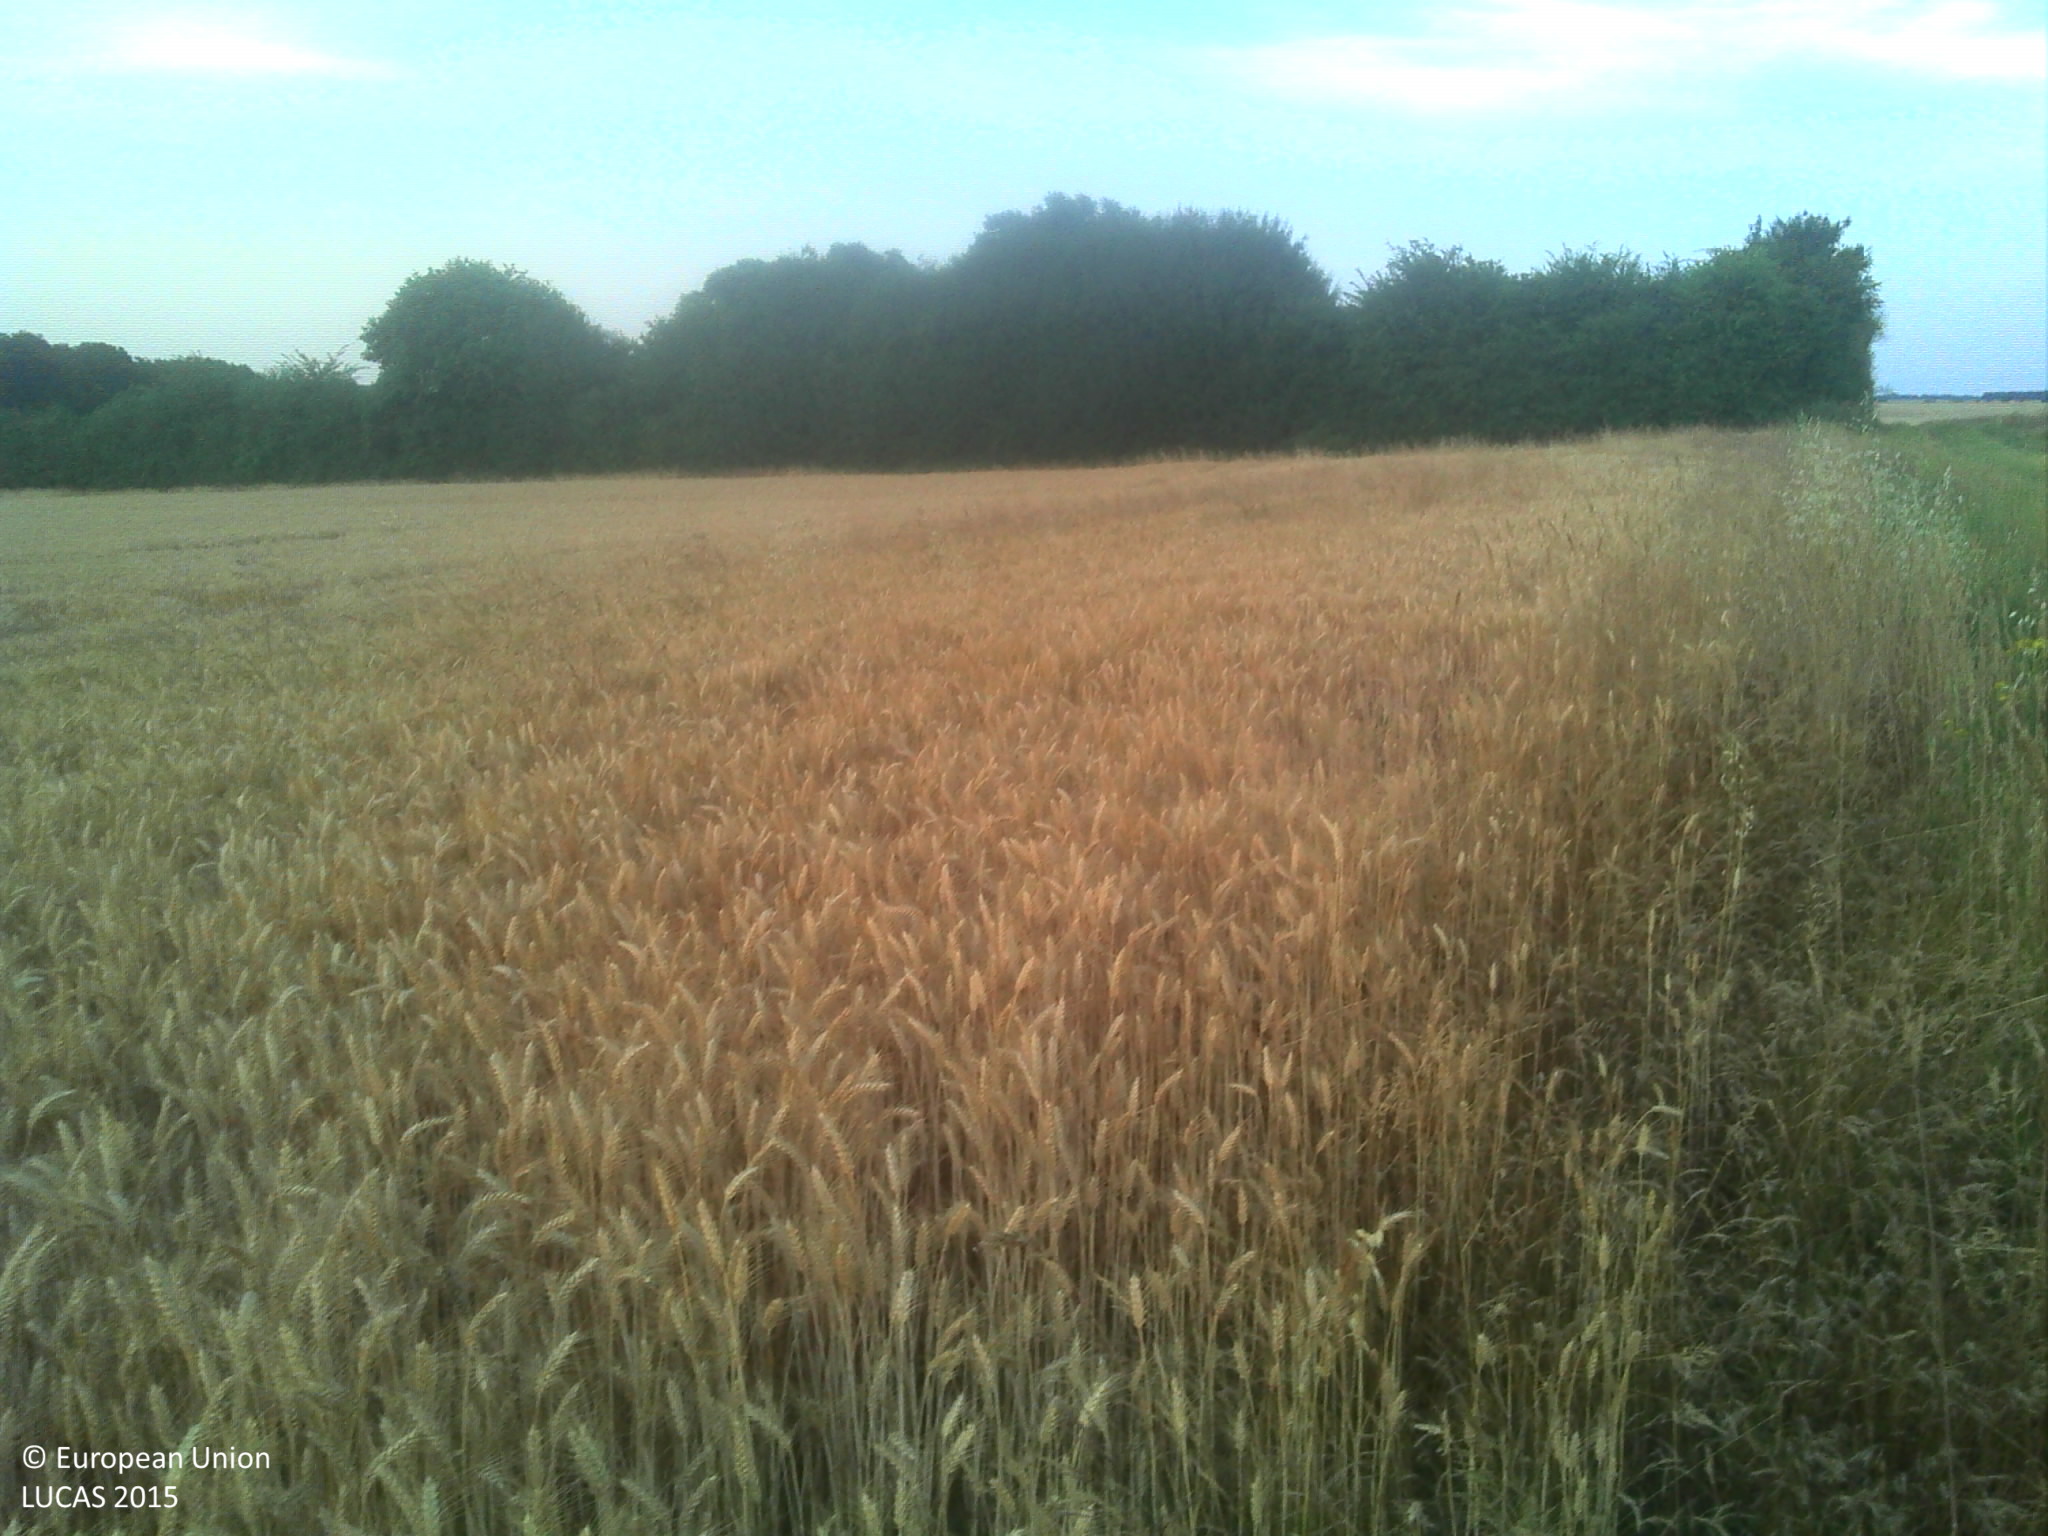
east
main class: Cropland
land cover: Common wheat
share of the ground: > 75 %
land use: Agriculture (excluding fallow land and kitchen gardens)
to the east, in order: Common wheat; Grass margins; Abandoned hedges; Grass margins; Maize
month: July
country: FR
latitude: 47.7244
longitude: 0.9557
